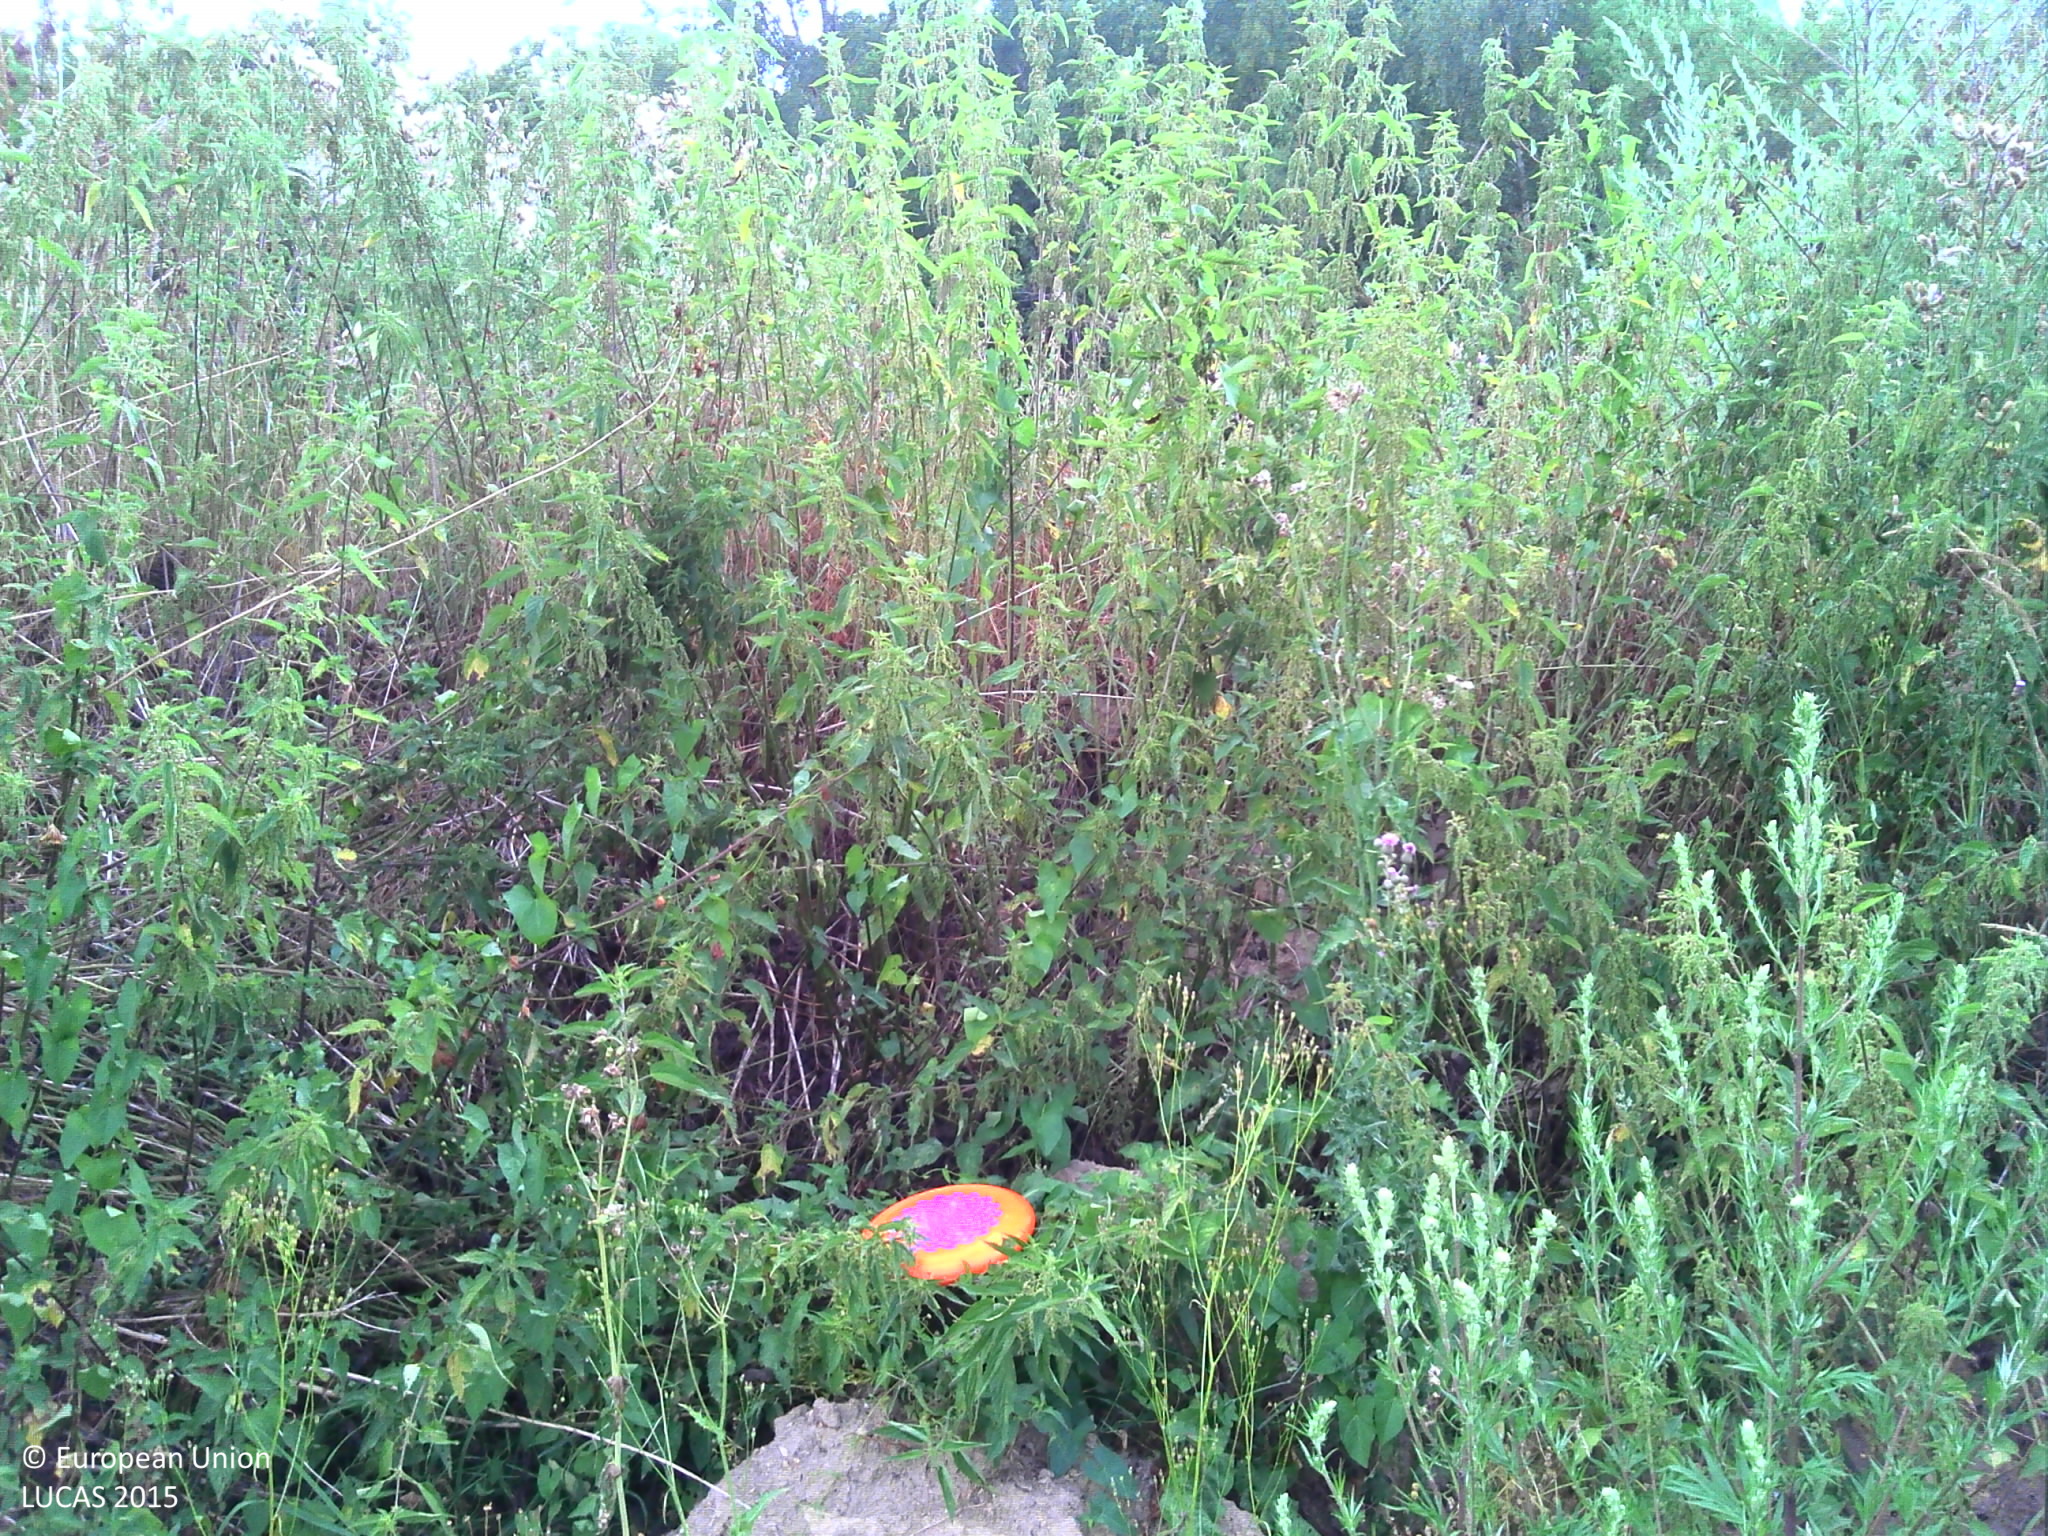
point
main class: Grassland
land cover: Spontaneously vegetated surfaces
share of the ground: > 75 %
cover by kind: herbaceous plants 95 %
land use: Semi-natural and natural areas not in use
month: July
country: FR
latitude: 45.6690
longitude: 1.0692
